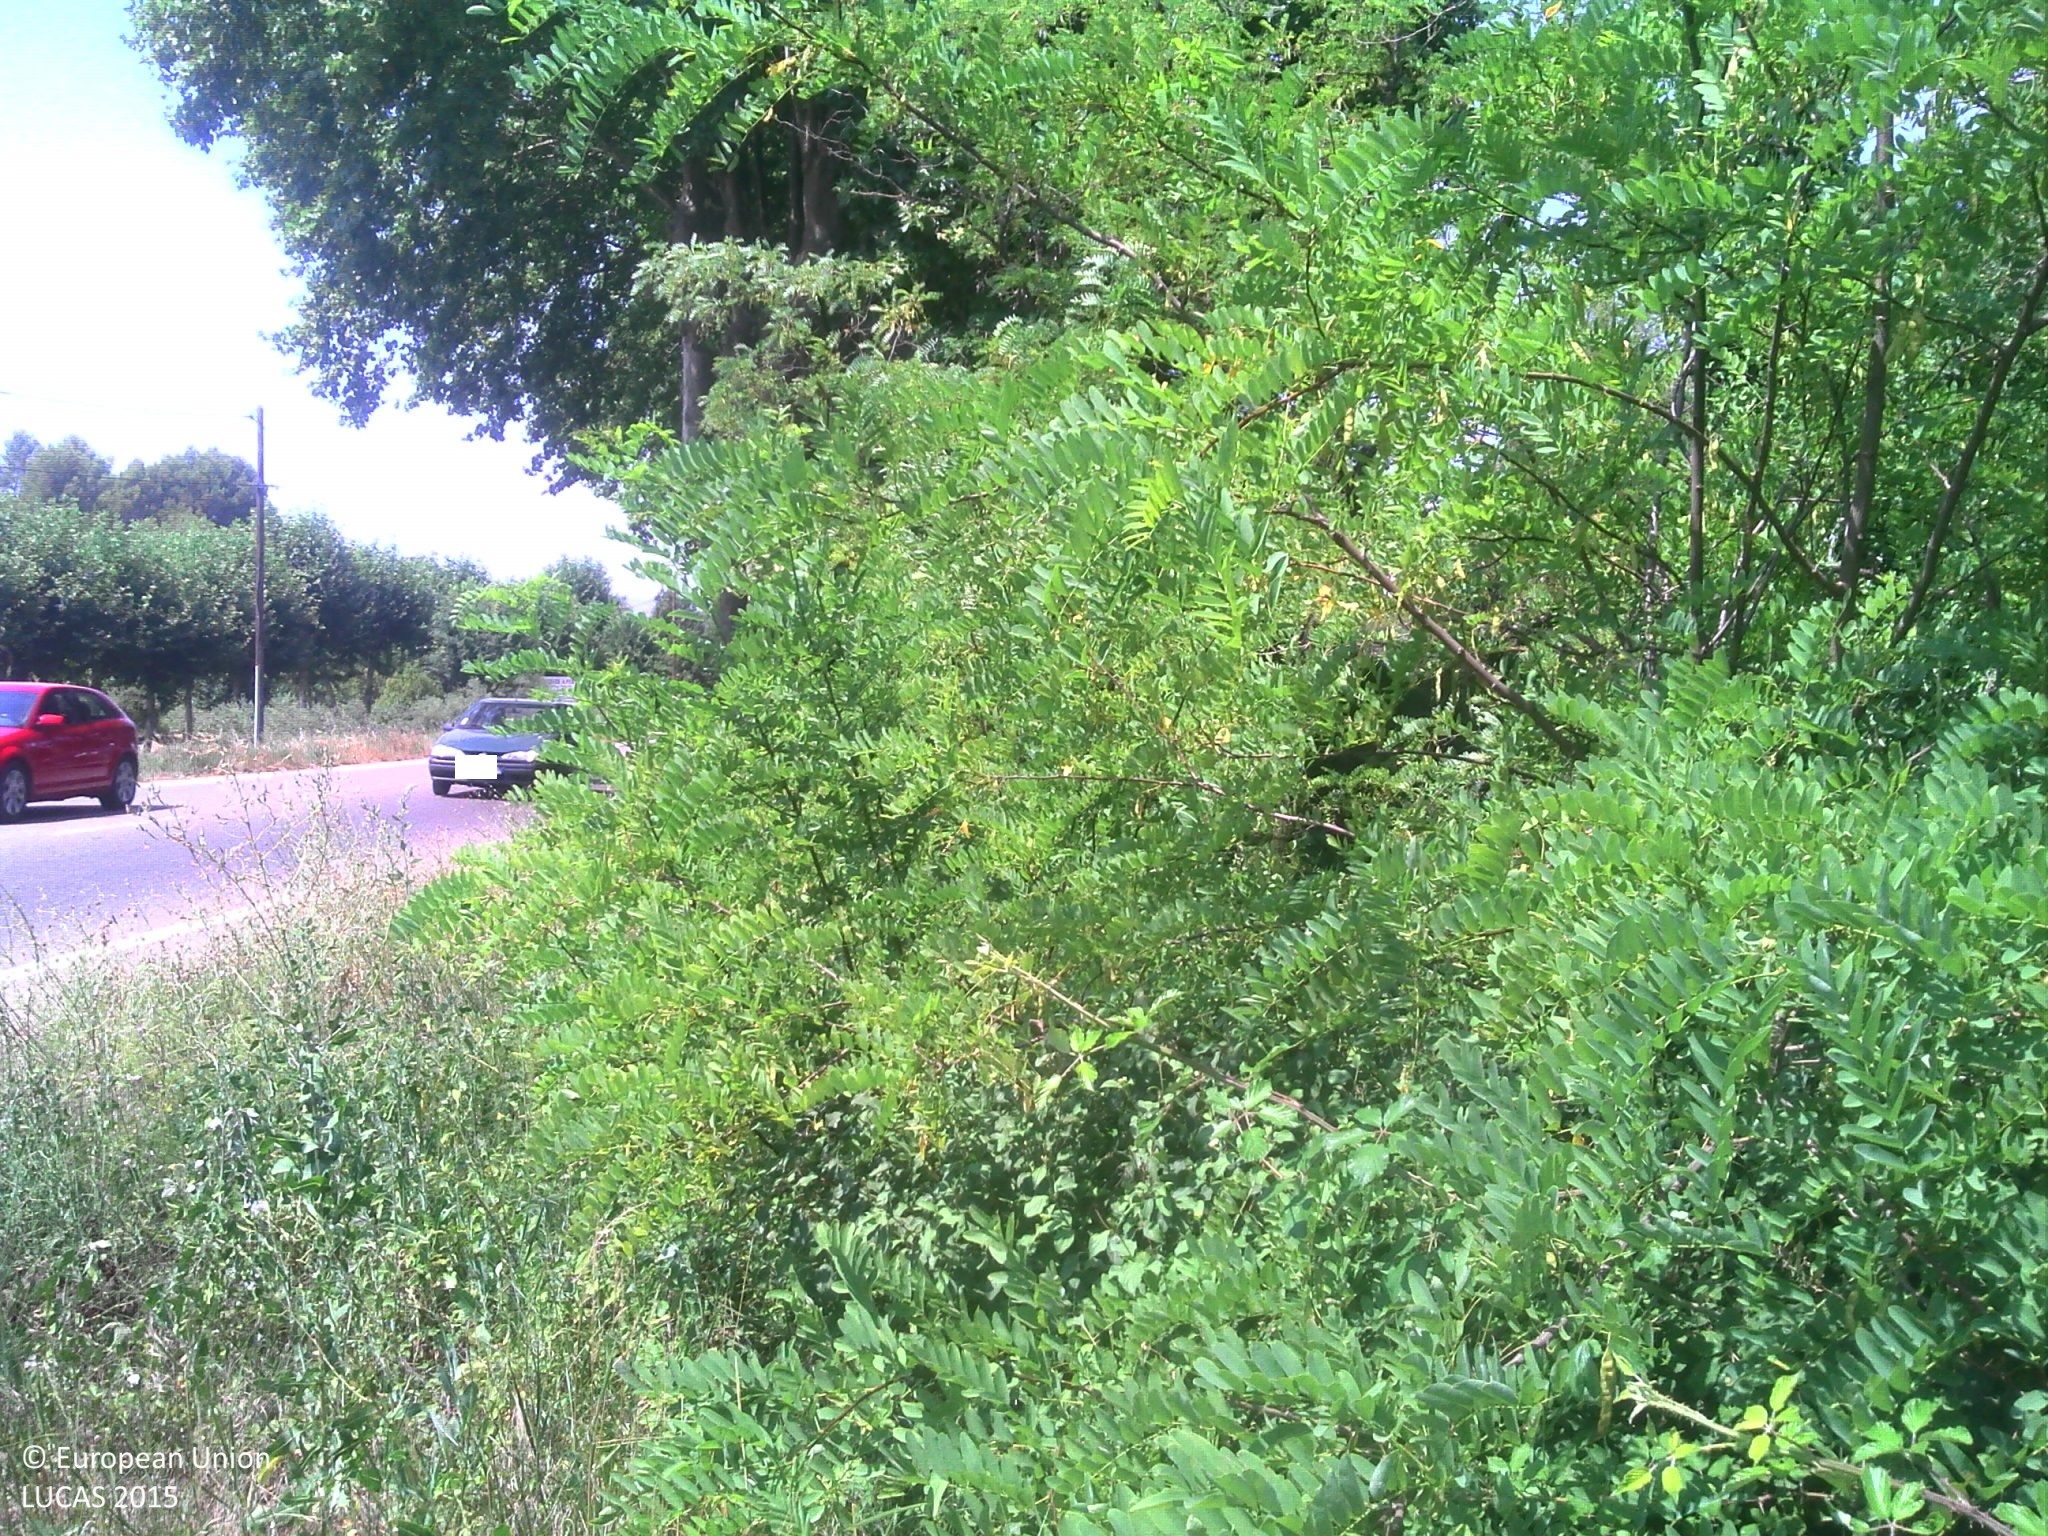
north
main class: Woodland
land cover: Broadleaved woodland
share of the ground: 25 - 50 %
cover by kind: herbaceous plants 50 %, broadleaved forest trees 30 %, shrubs 20 %
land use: Semi-natural and natural areas not in use
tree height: > 5 m
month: July
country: FR
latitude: 43.6978
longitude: 5.2074
